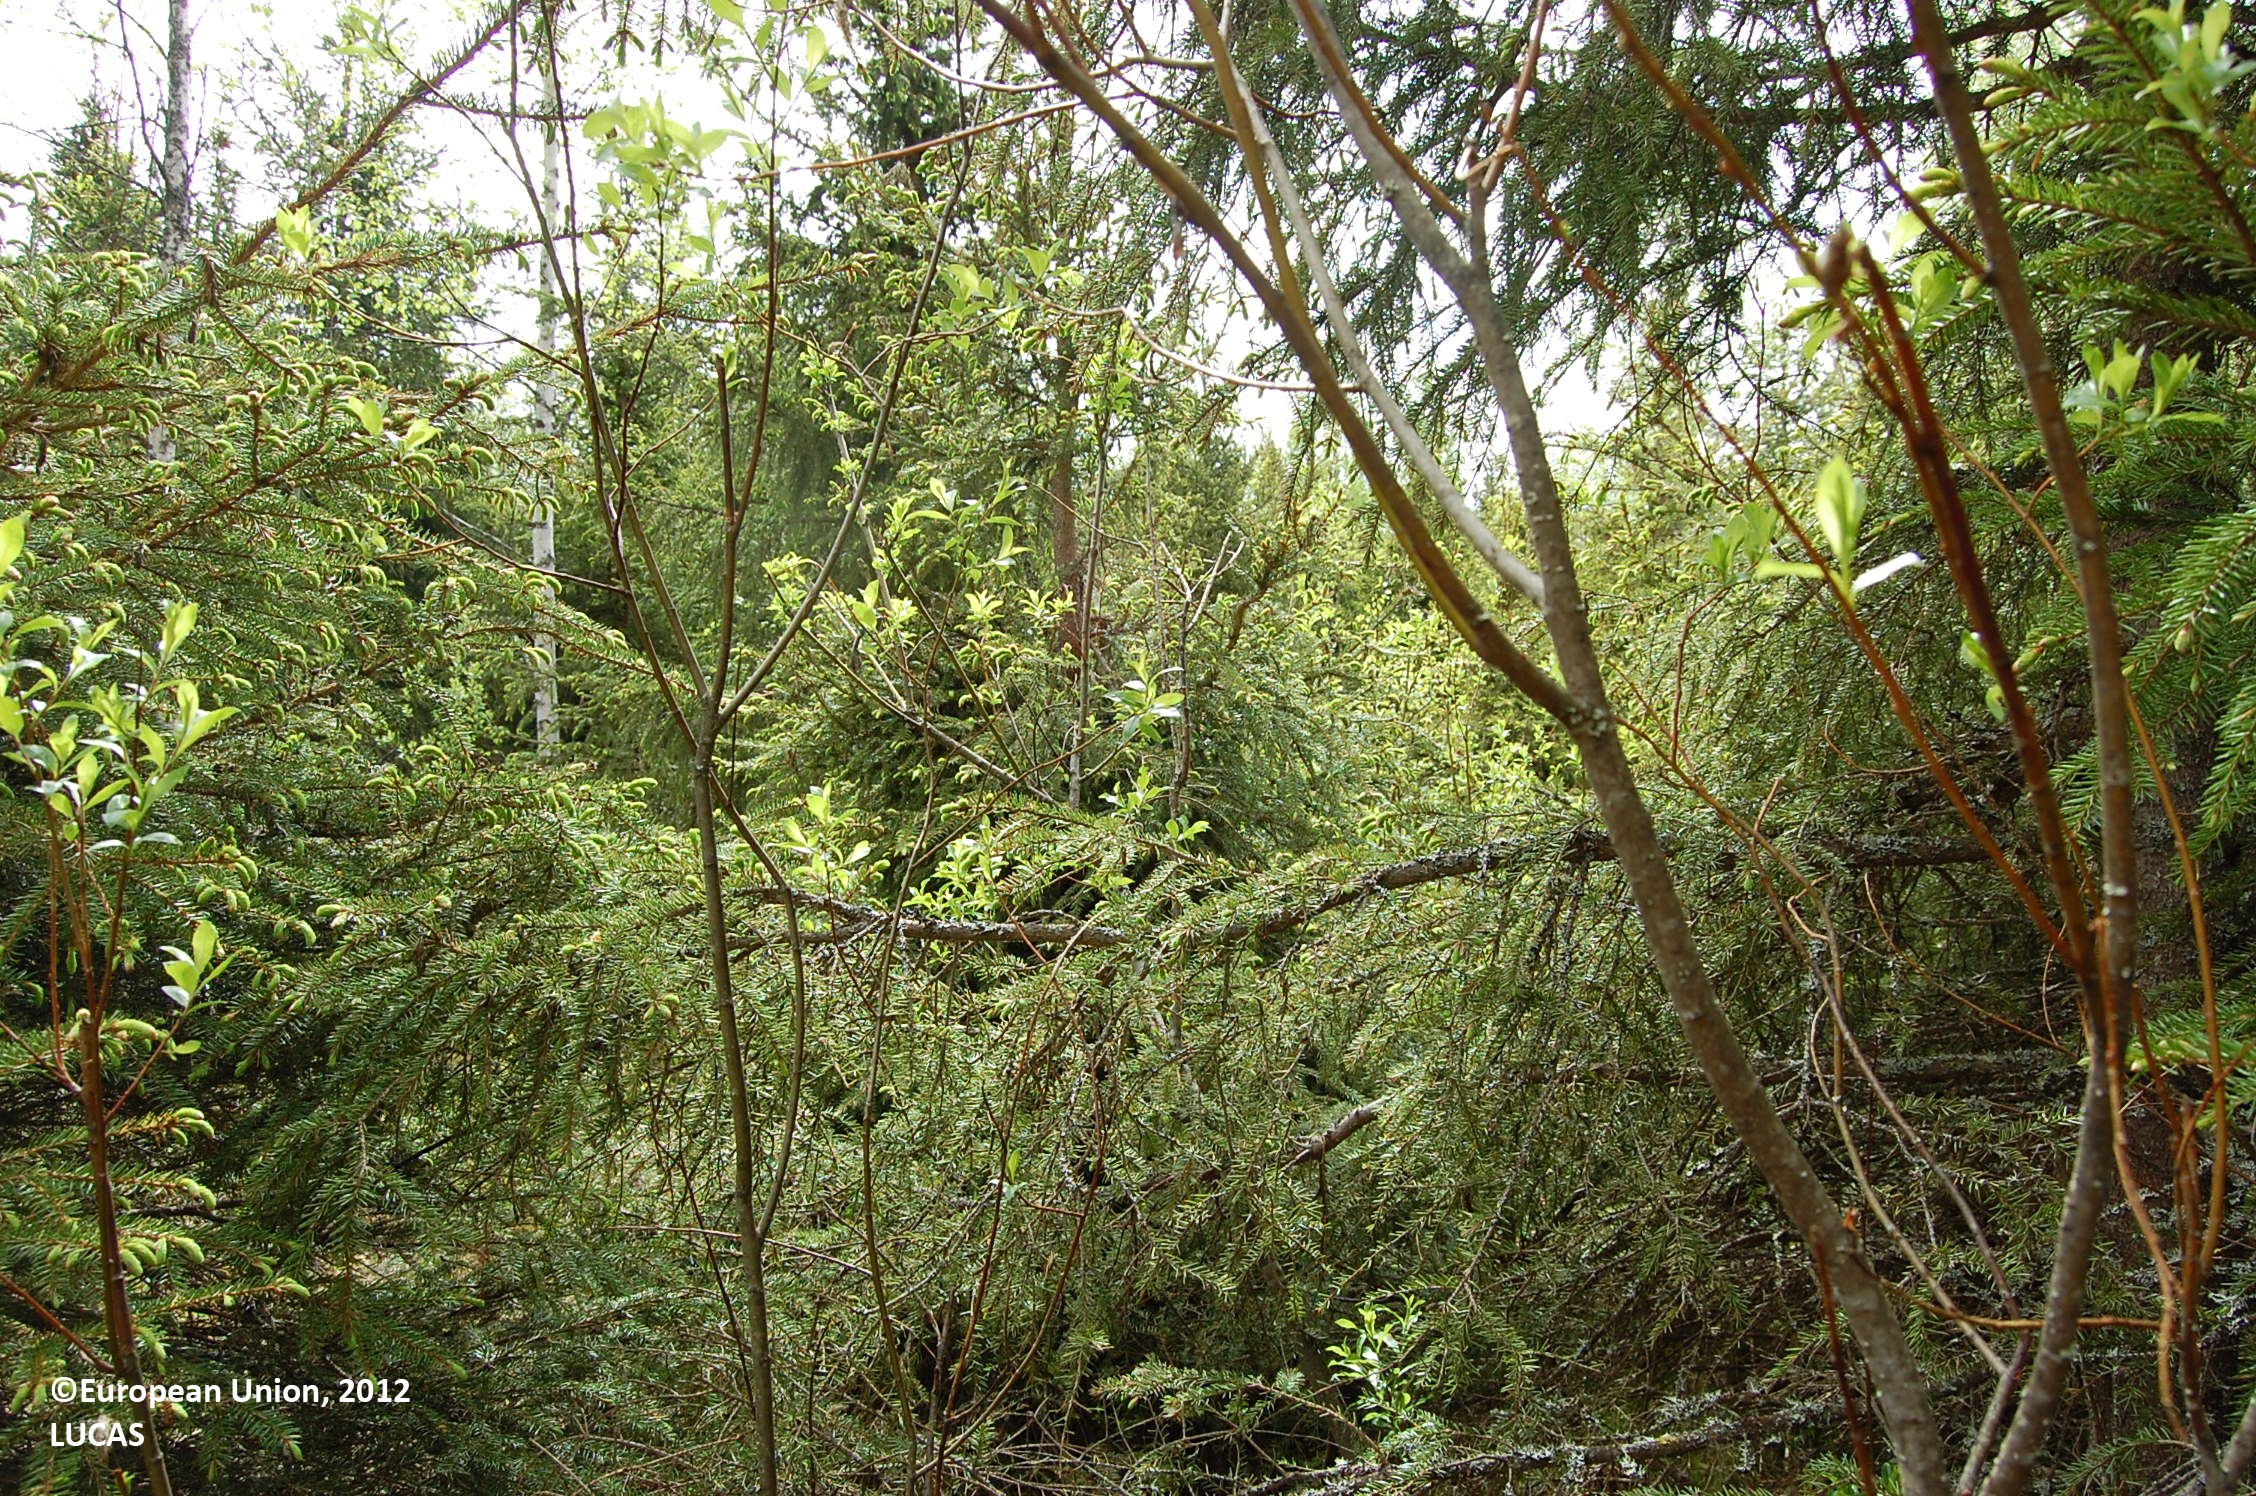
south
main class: Woodland
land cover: Spruce dominated mixed woodland
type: hemiboreal forest and nemoral coniferous forest and mixed broadleaved-coniferous forest
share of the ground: 50 - 75 %
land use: Forestry
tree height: > 5 m
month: June
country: FI
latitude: 64.0096
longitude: 26.1254
